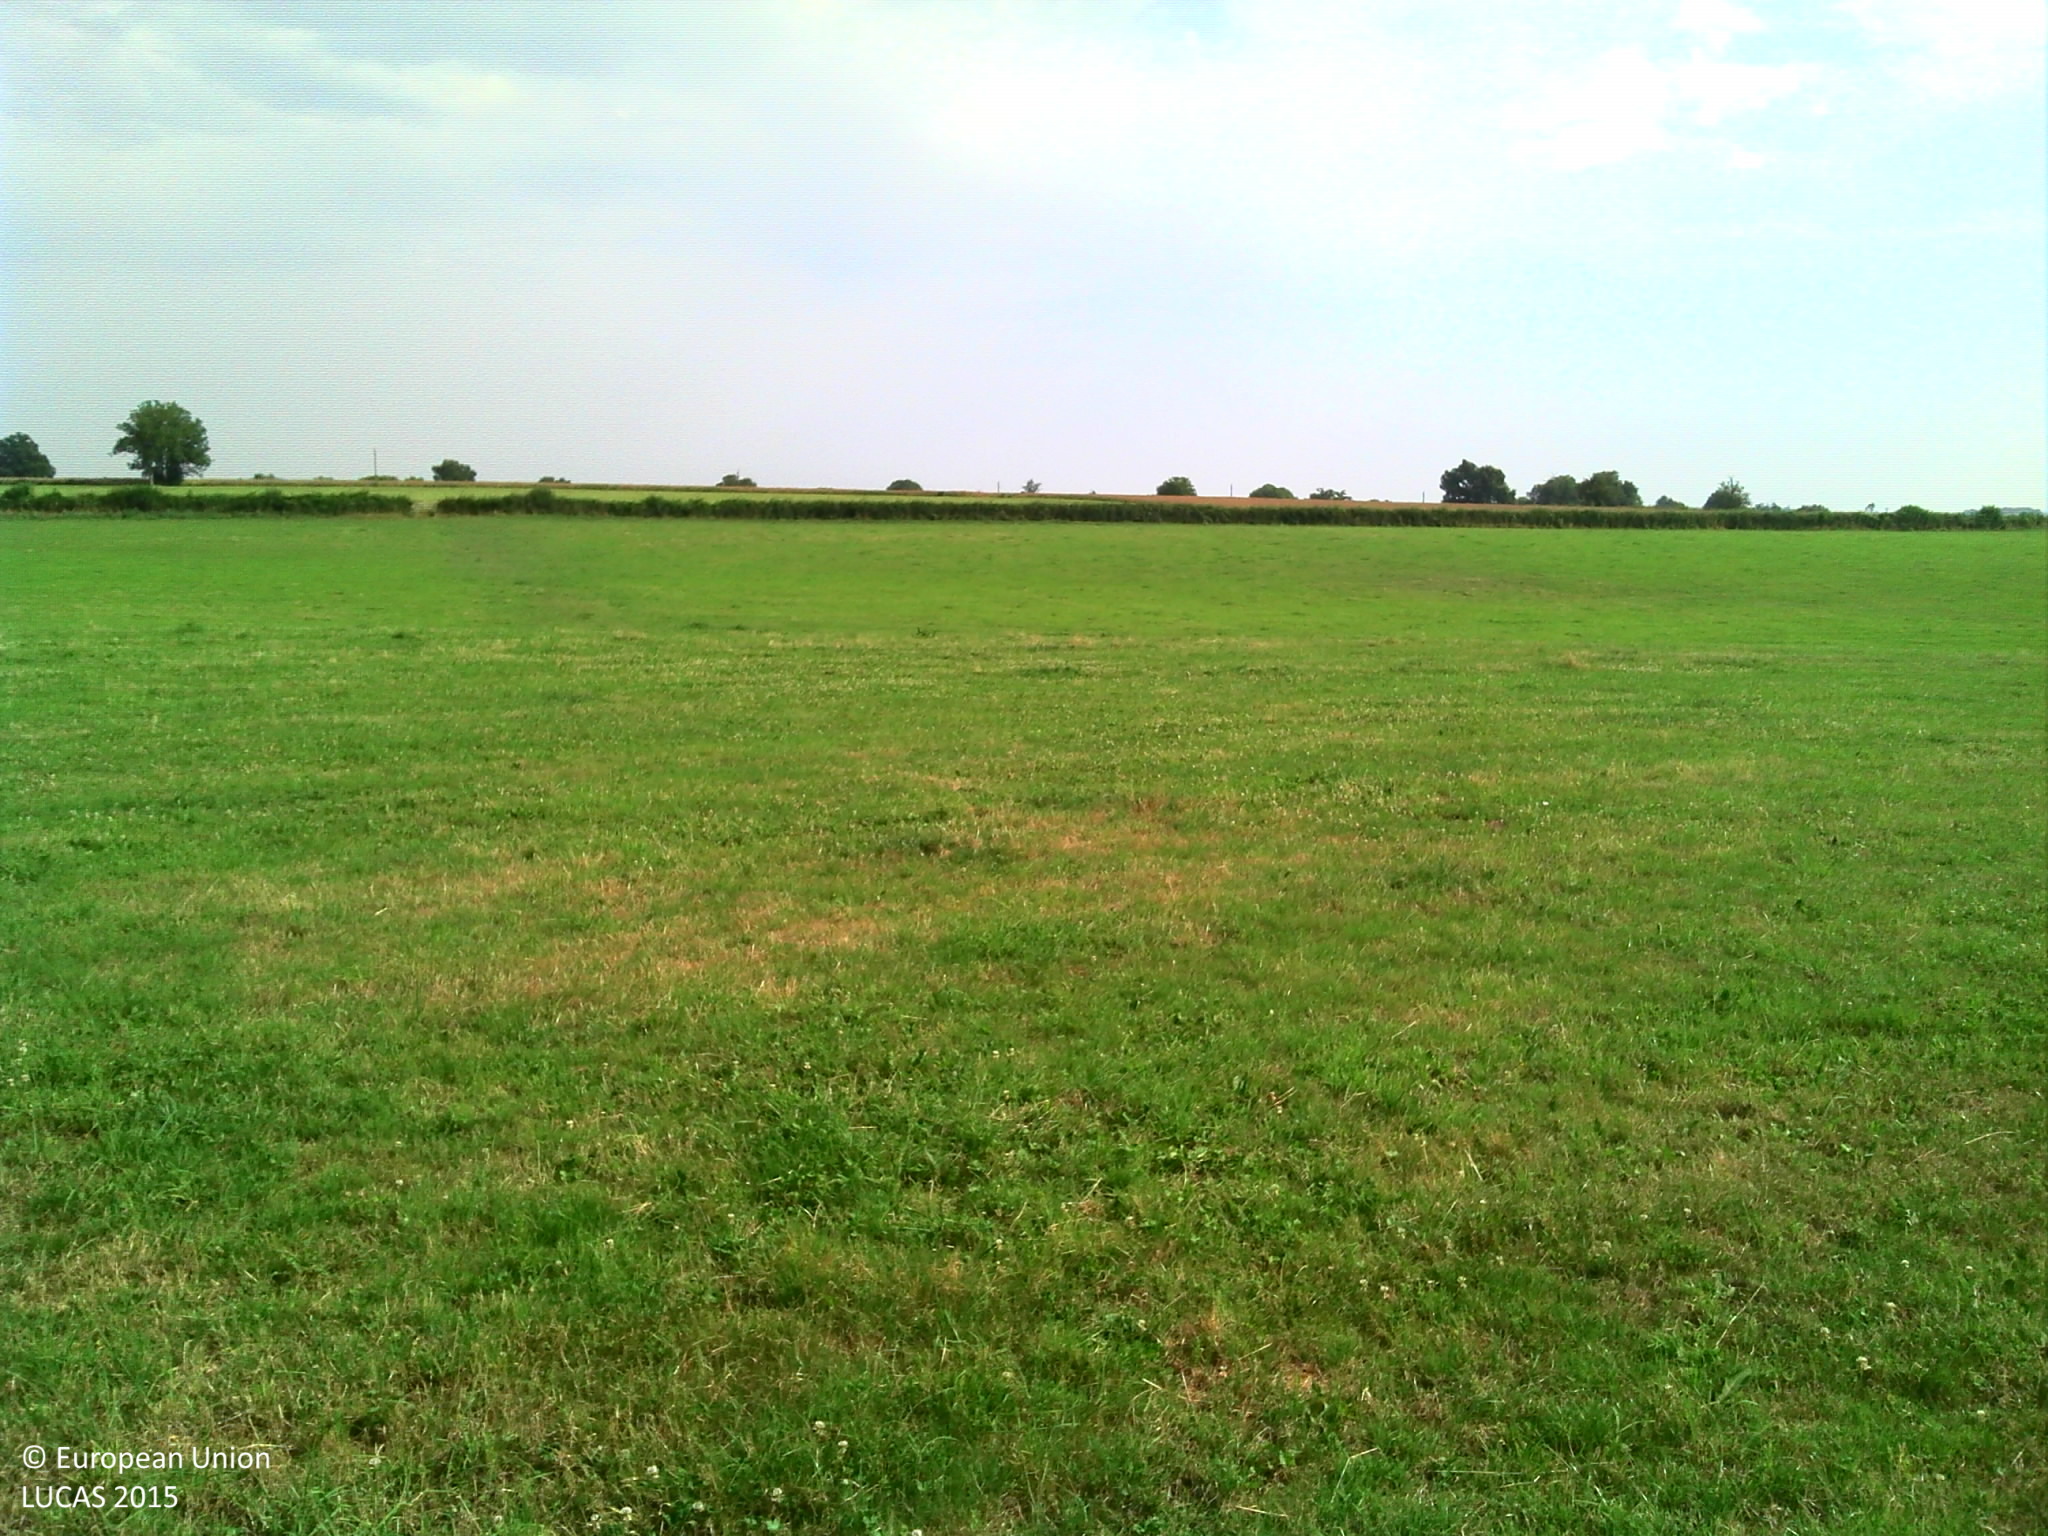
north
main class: Grassland
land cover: Grassland without tree/shrub cover
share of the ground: > 75 %
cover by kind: herbaceous plants 100 %
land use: Agriculture (excluding fallow land and kitchen gardens)
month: July
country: FR
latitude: 47.1350
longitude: 3.6031
